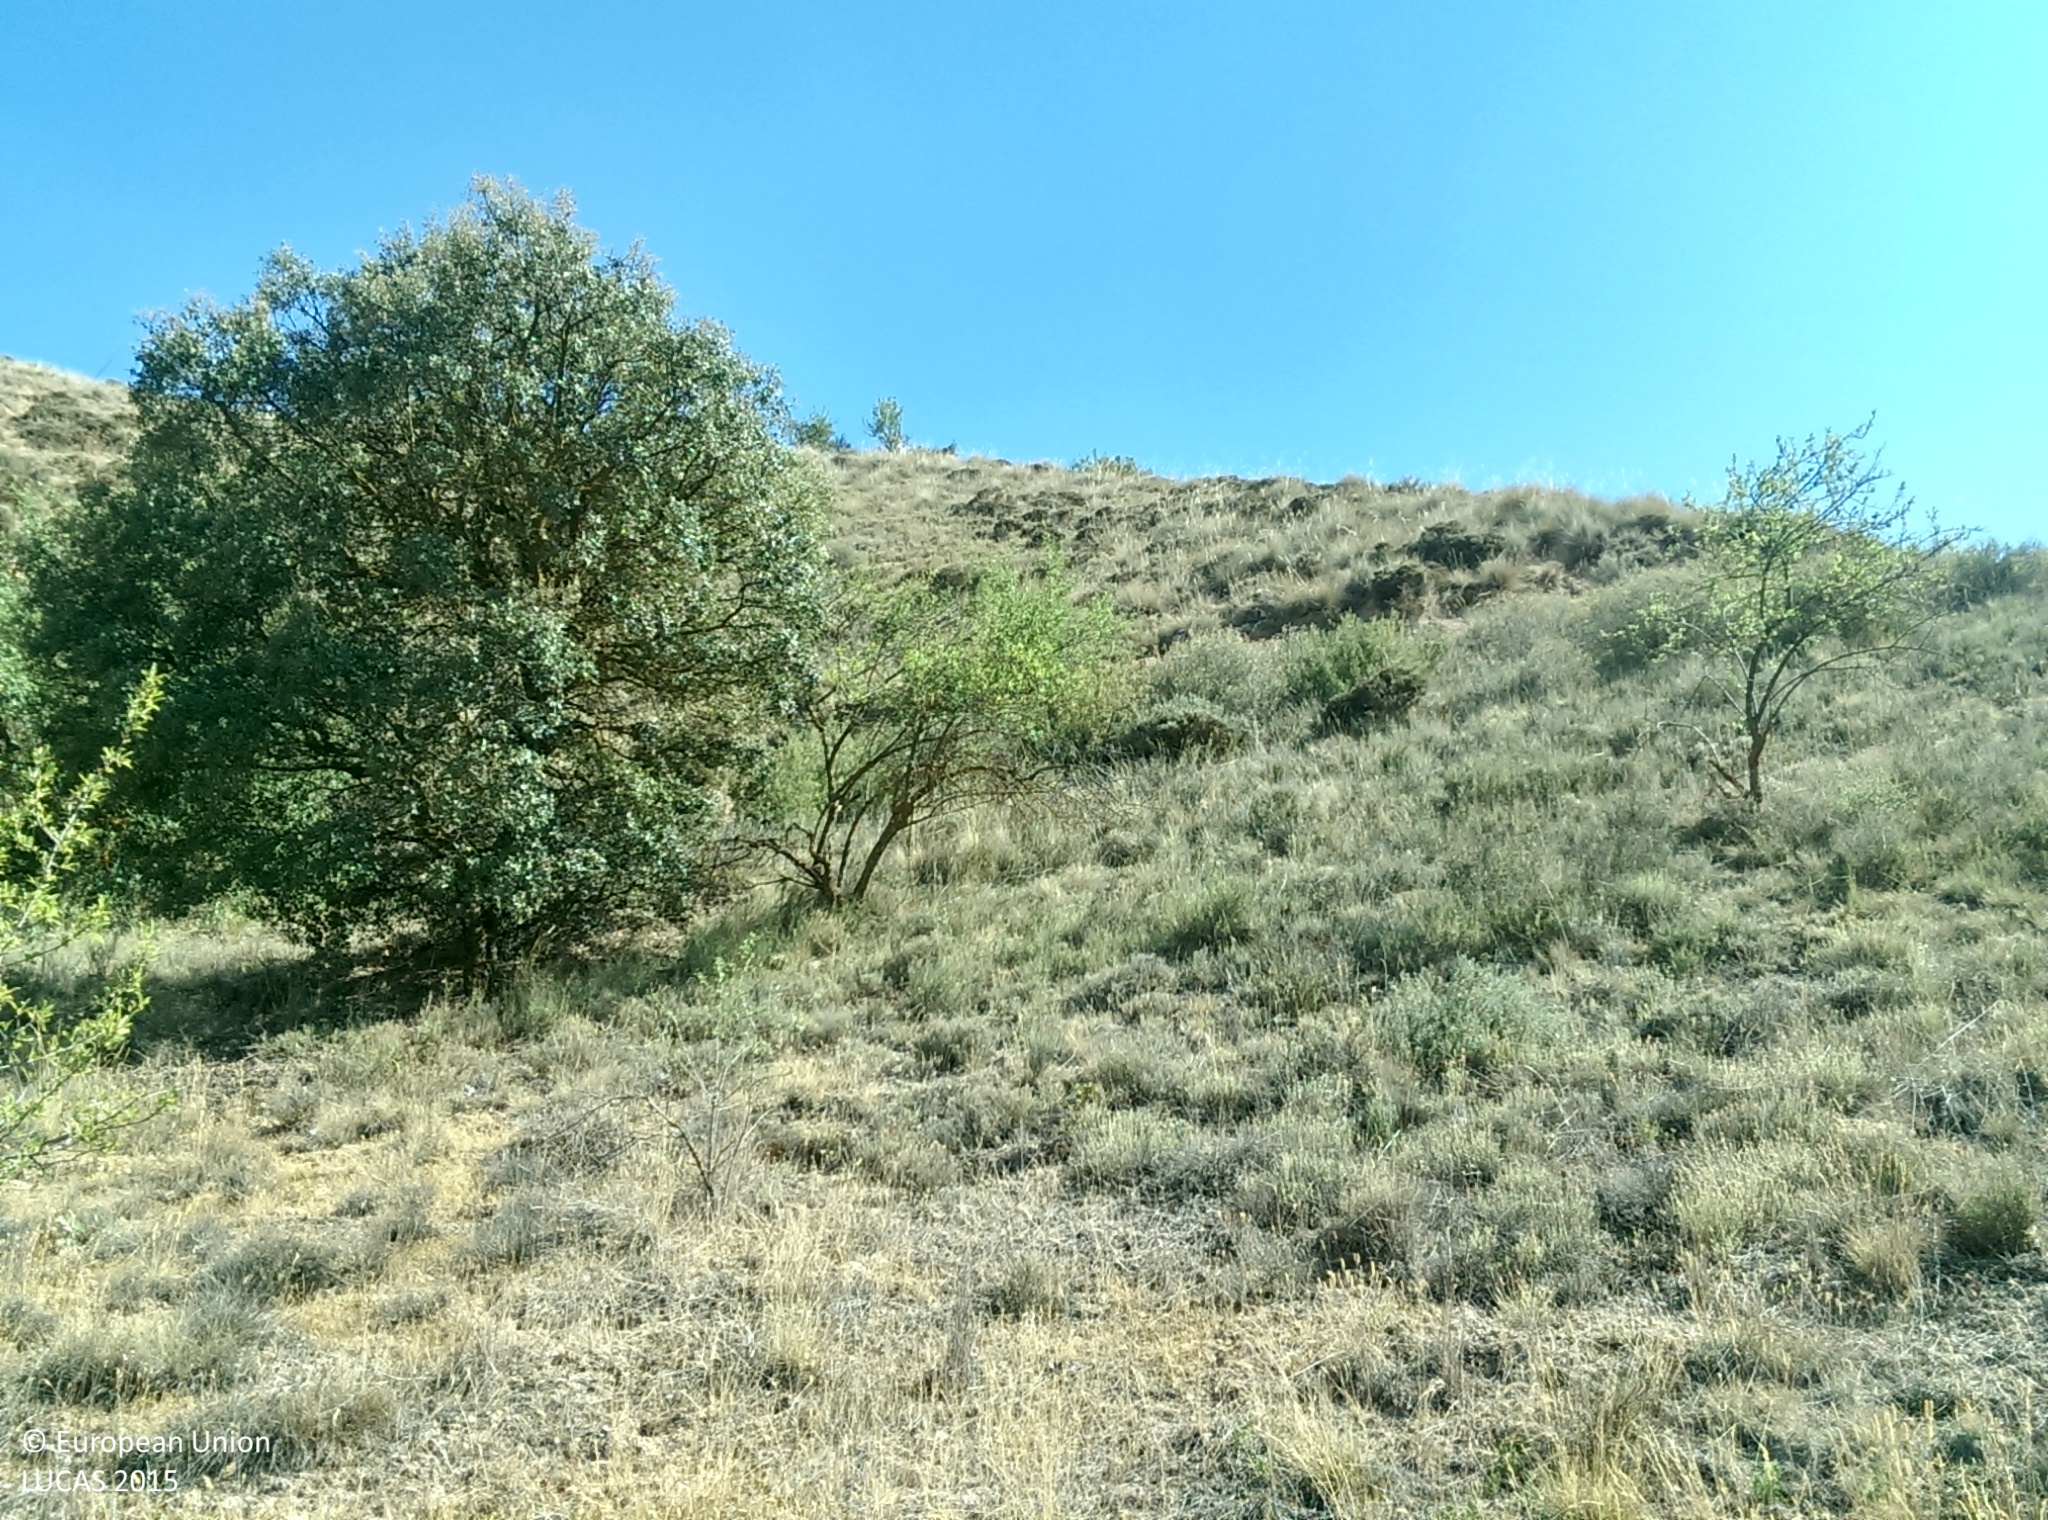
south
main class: Cropland
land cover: Nuts trees
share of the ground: 10 - 25 %
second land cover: Grassland without tree/shrub cover
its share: > 75 %
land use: Agriculture (excluding fallow land and kitchen gardens)
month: June
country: ES
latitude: 37.5651
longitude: -3.2723
